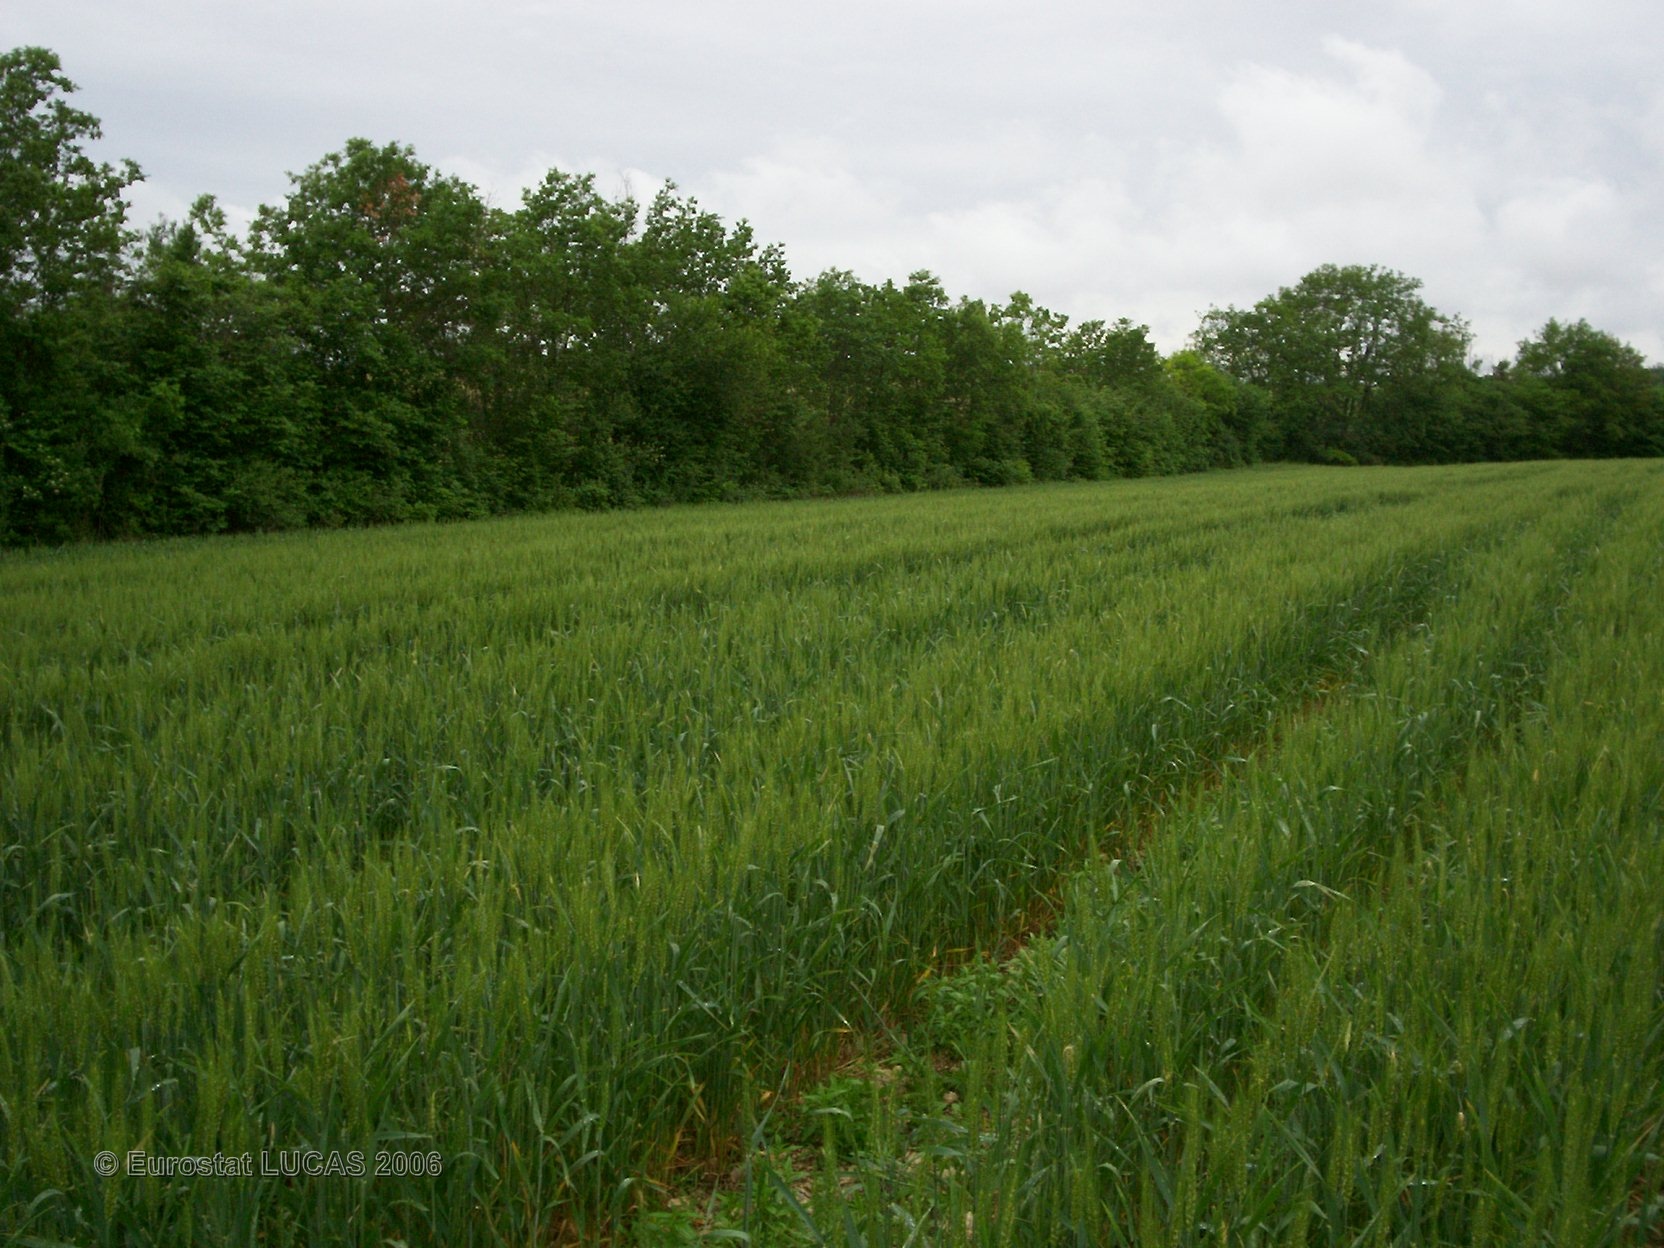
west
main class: Cropland
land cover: Triticale
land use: Agriculture (excluding fallow land and kitchen gardens)
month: May
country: FR
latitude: 45.3879
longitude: 0.5492
